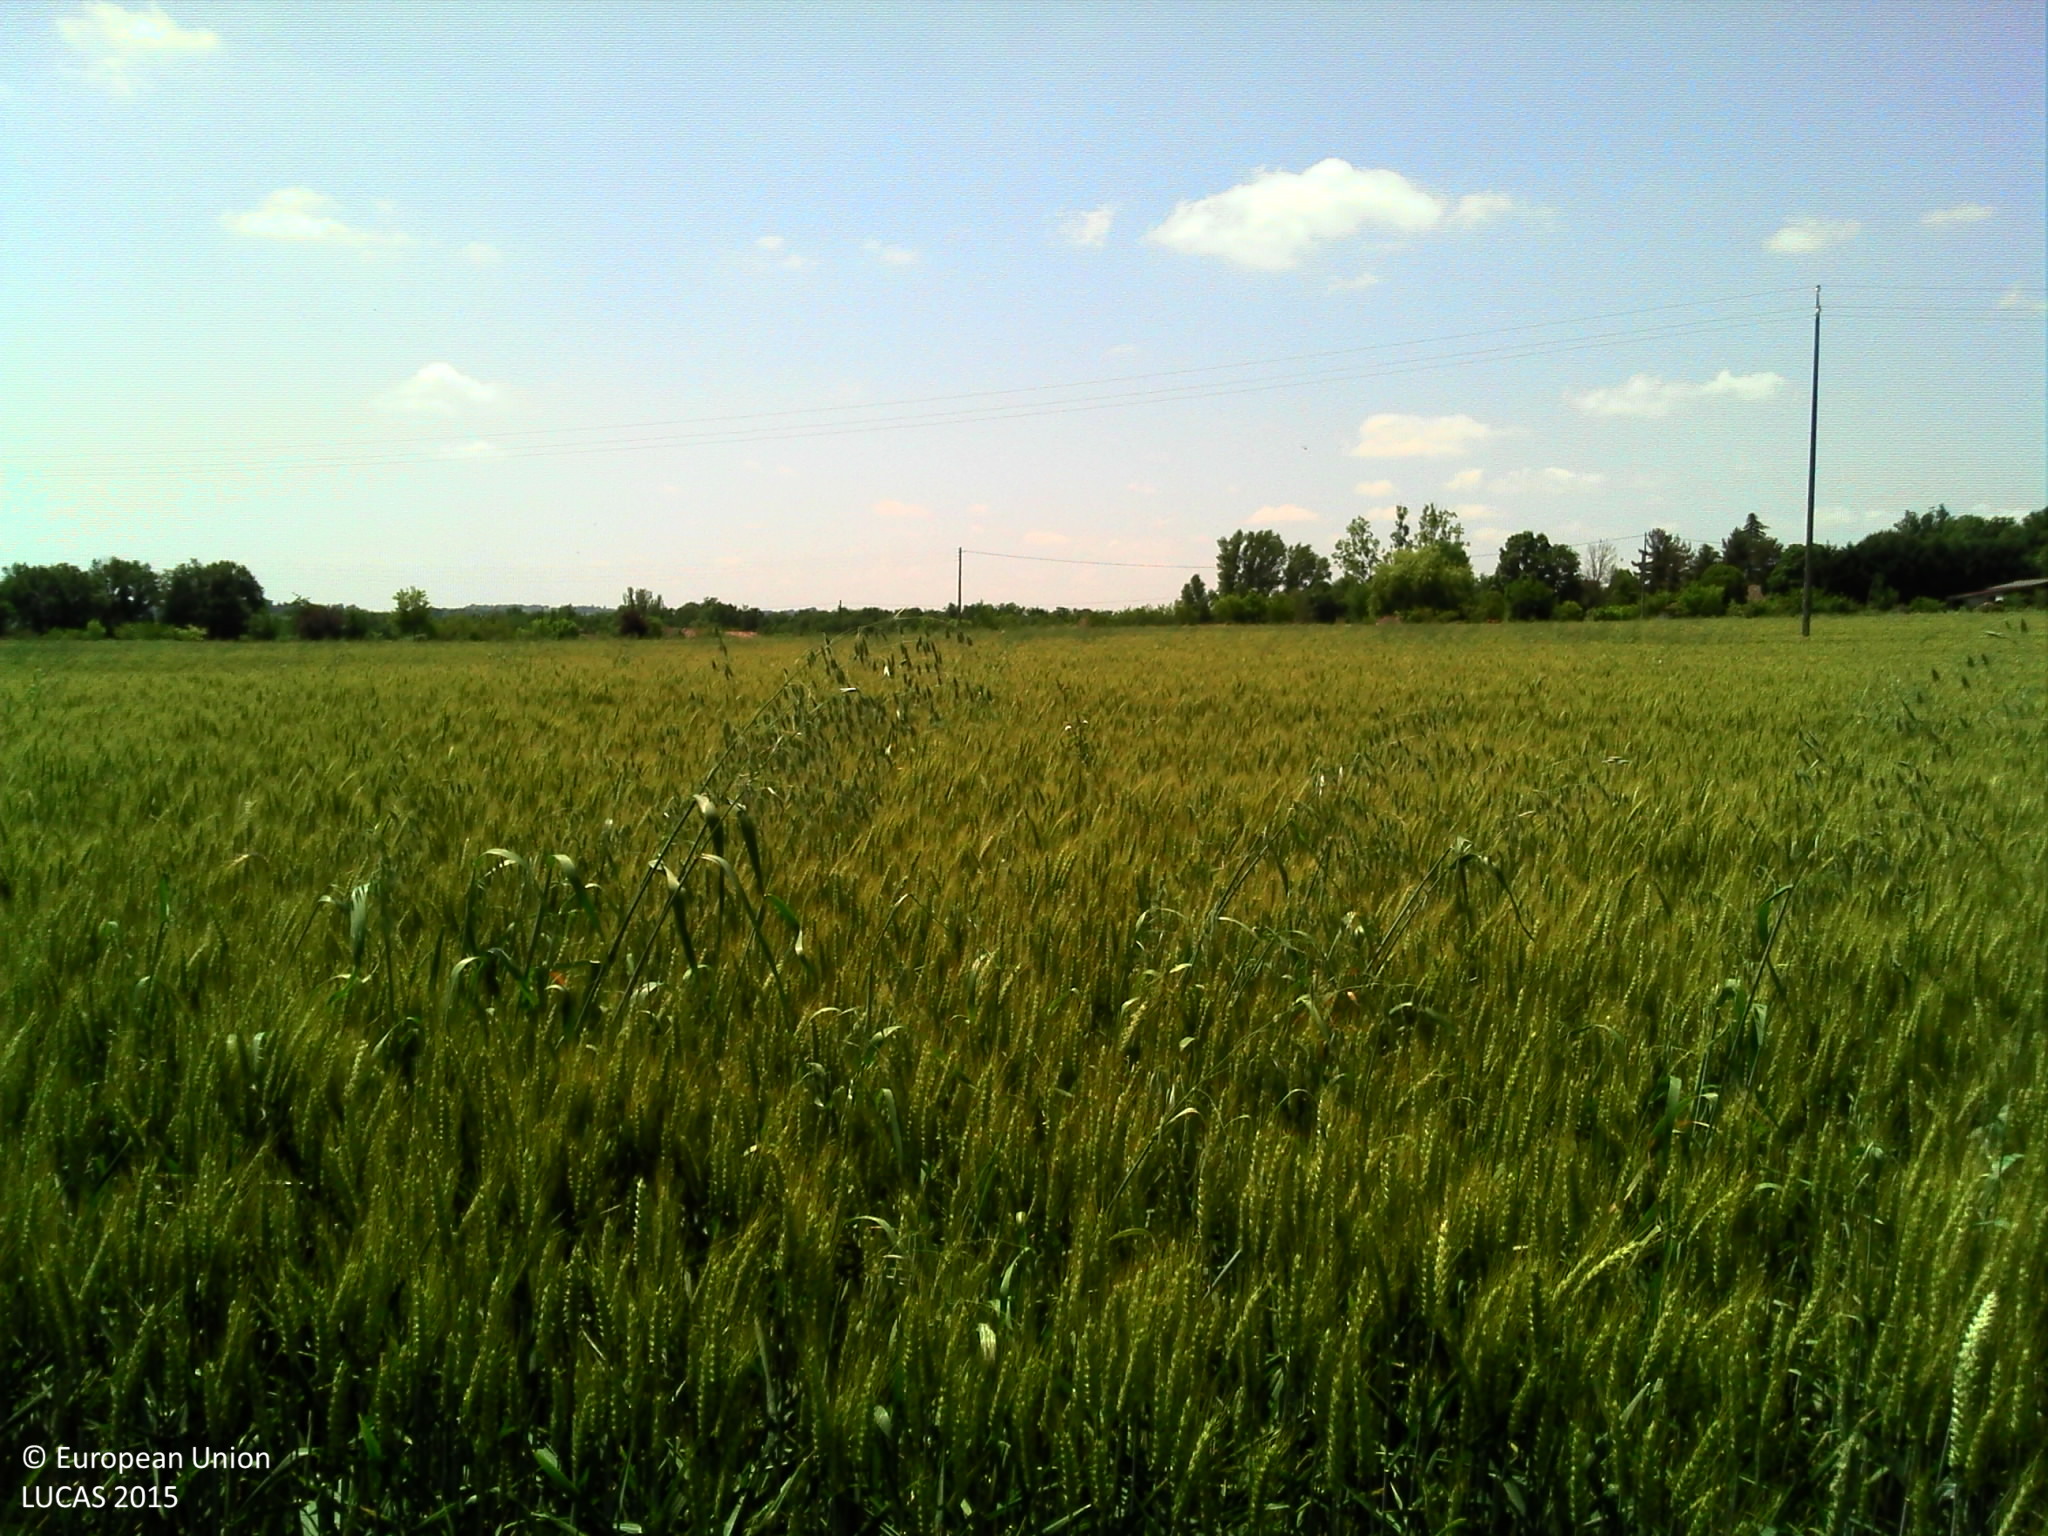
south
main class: Cropland
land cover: Common wheat
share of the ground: > 75 %
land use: Agriculture (excluding fallow land and kitchen gardens)
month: June
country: FR
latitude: 43.6295
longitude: 0.7653
